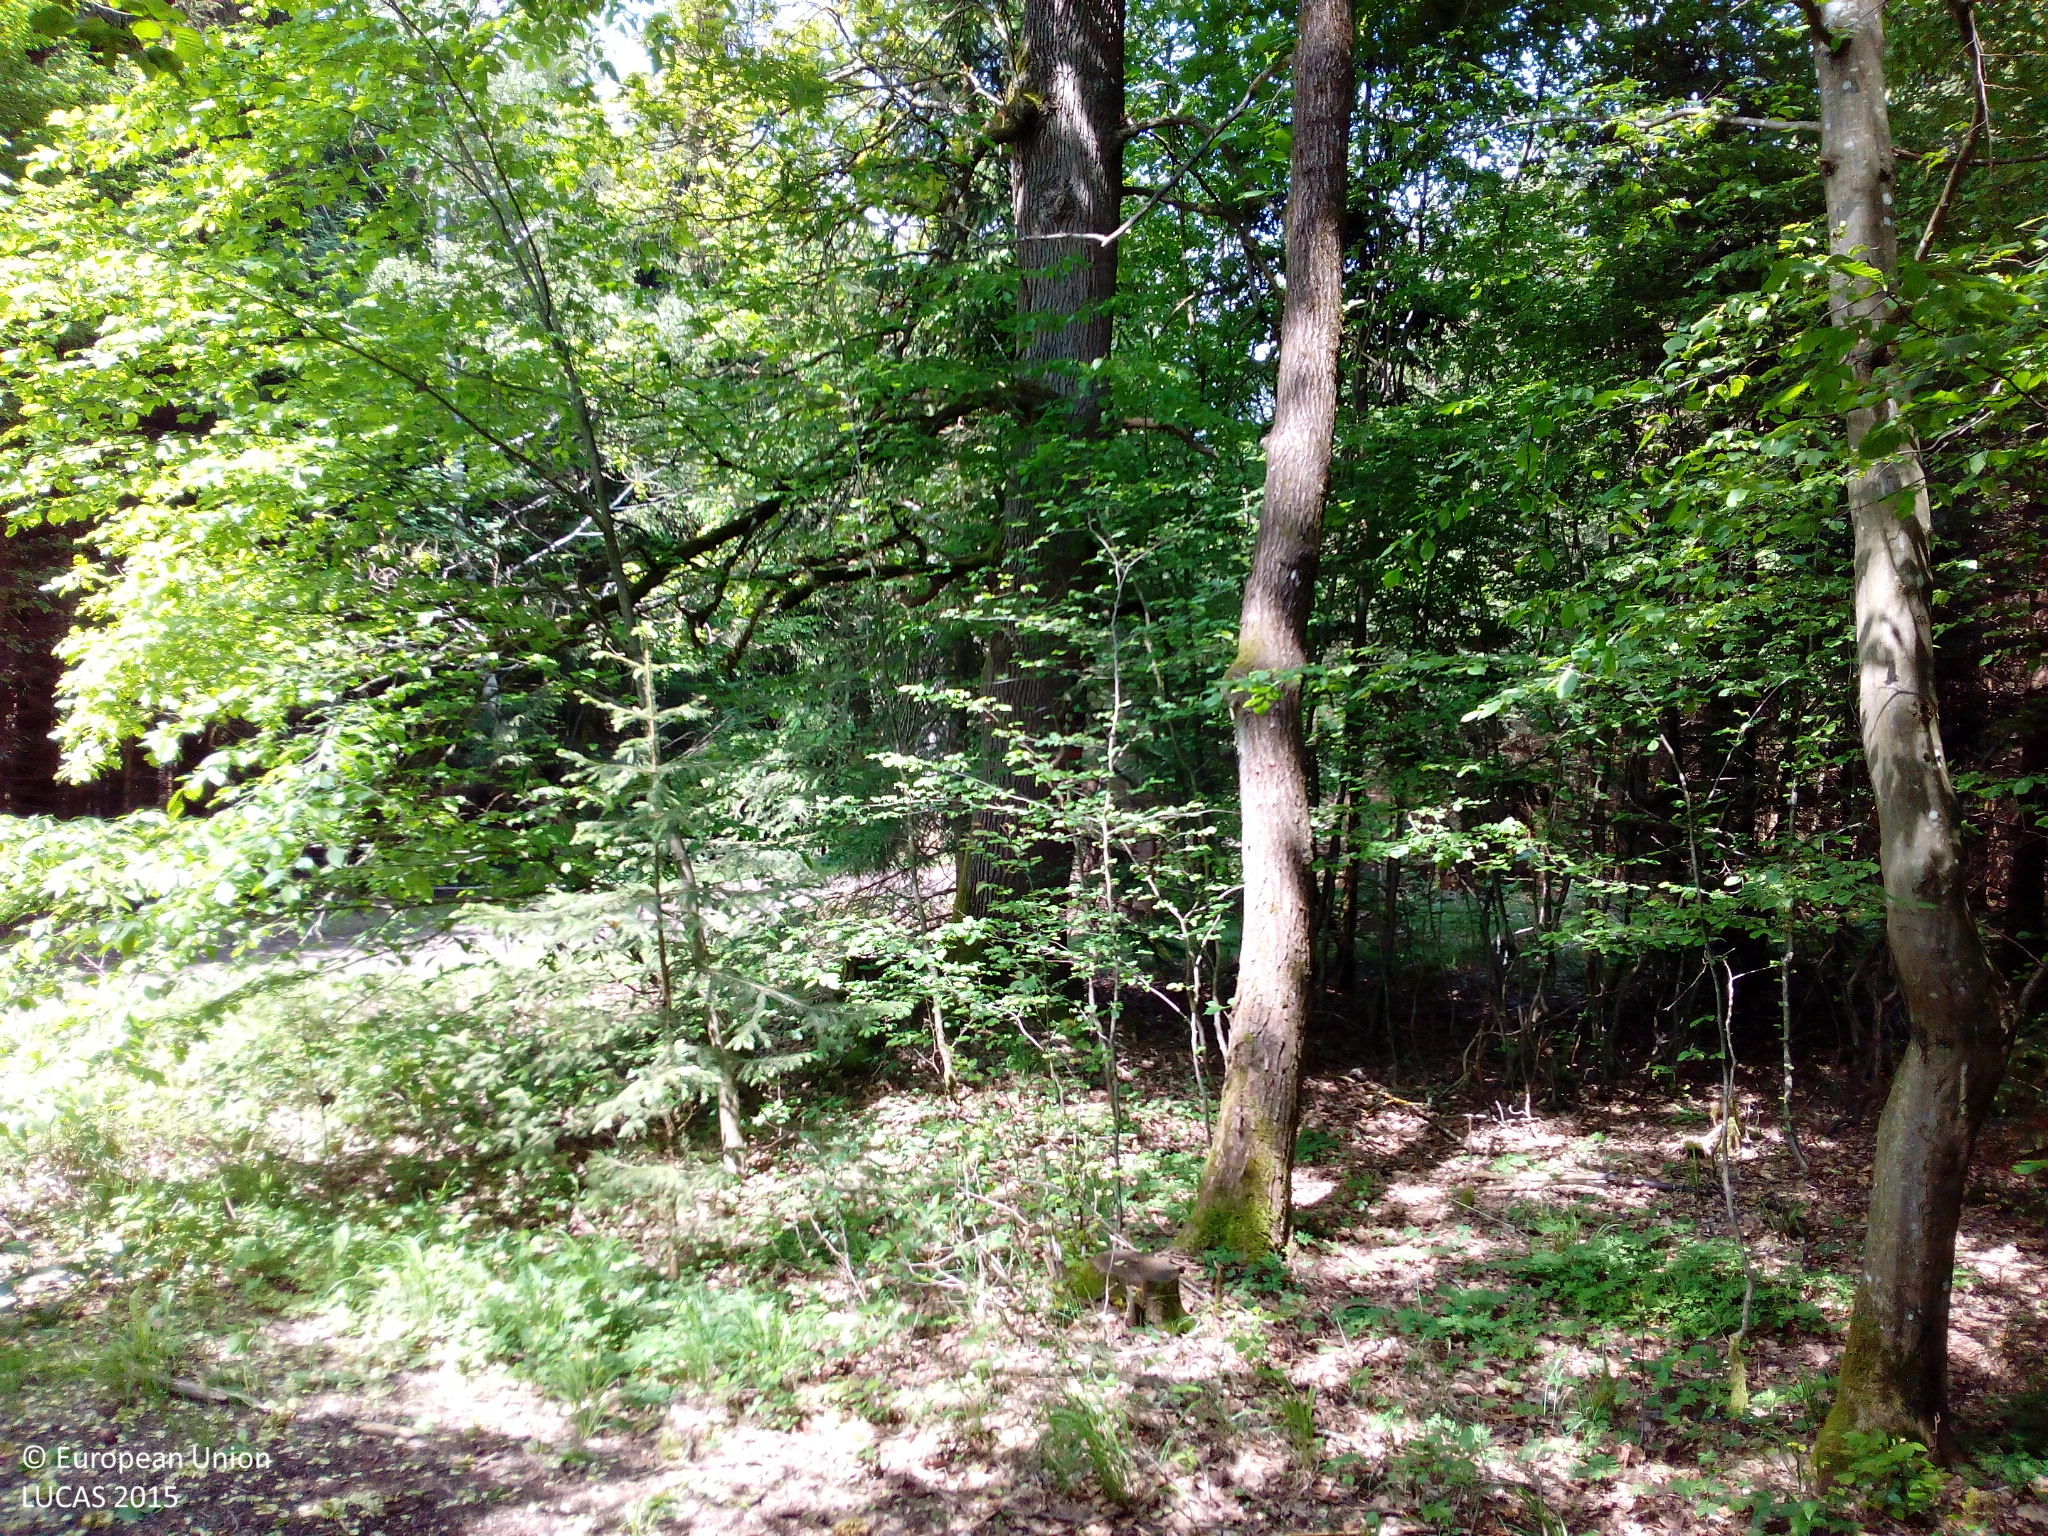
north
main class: Woodland
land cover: Broadleaved woodland
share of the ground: > 75 %
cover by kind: broadleaved forest trees 75 %, coniferous forest trees 25 %
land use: Forestry
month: May
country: DE
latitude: 48.1245
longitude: 11.4098
